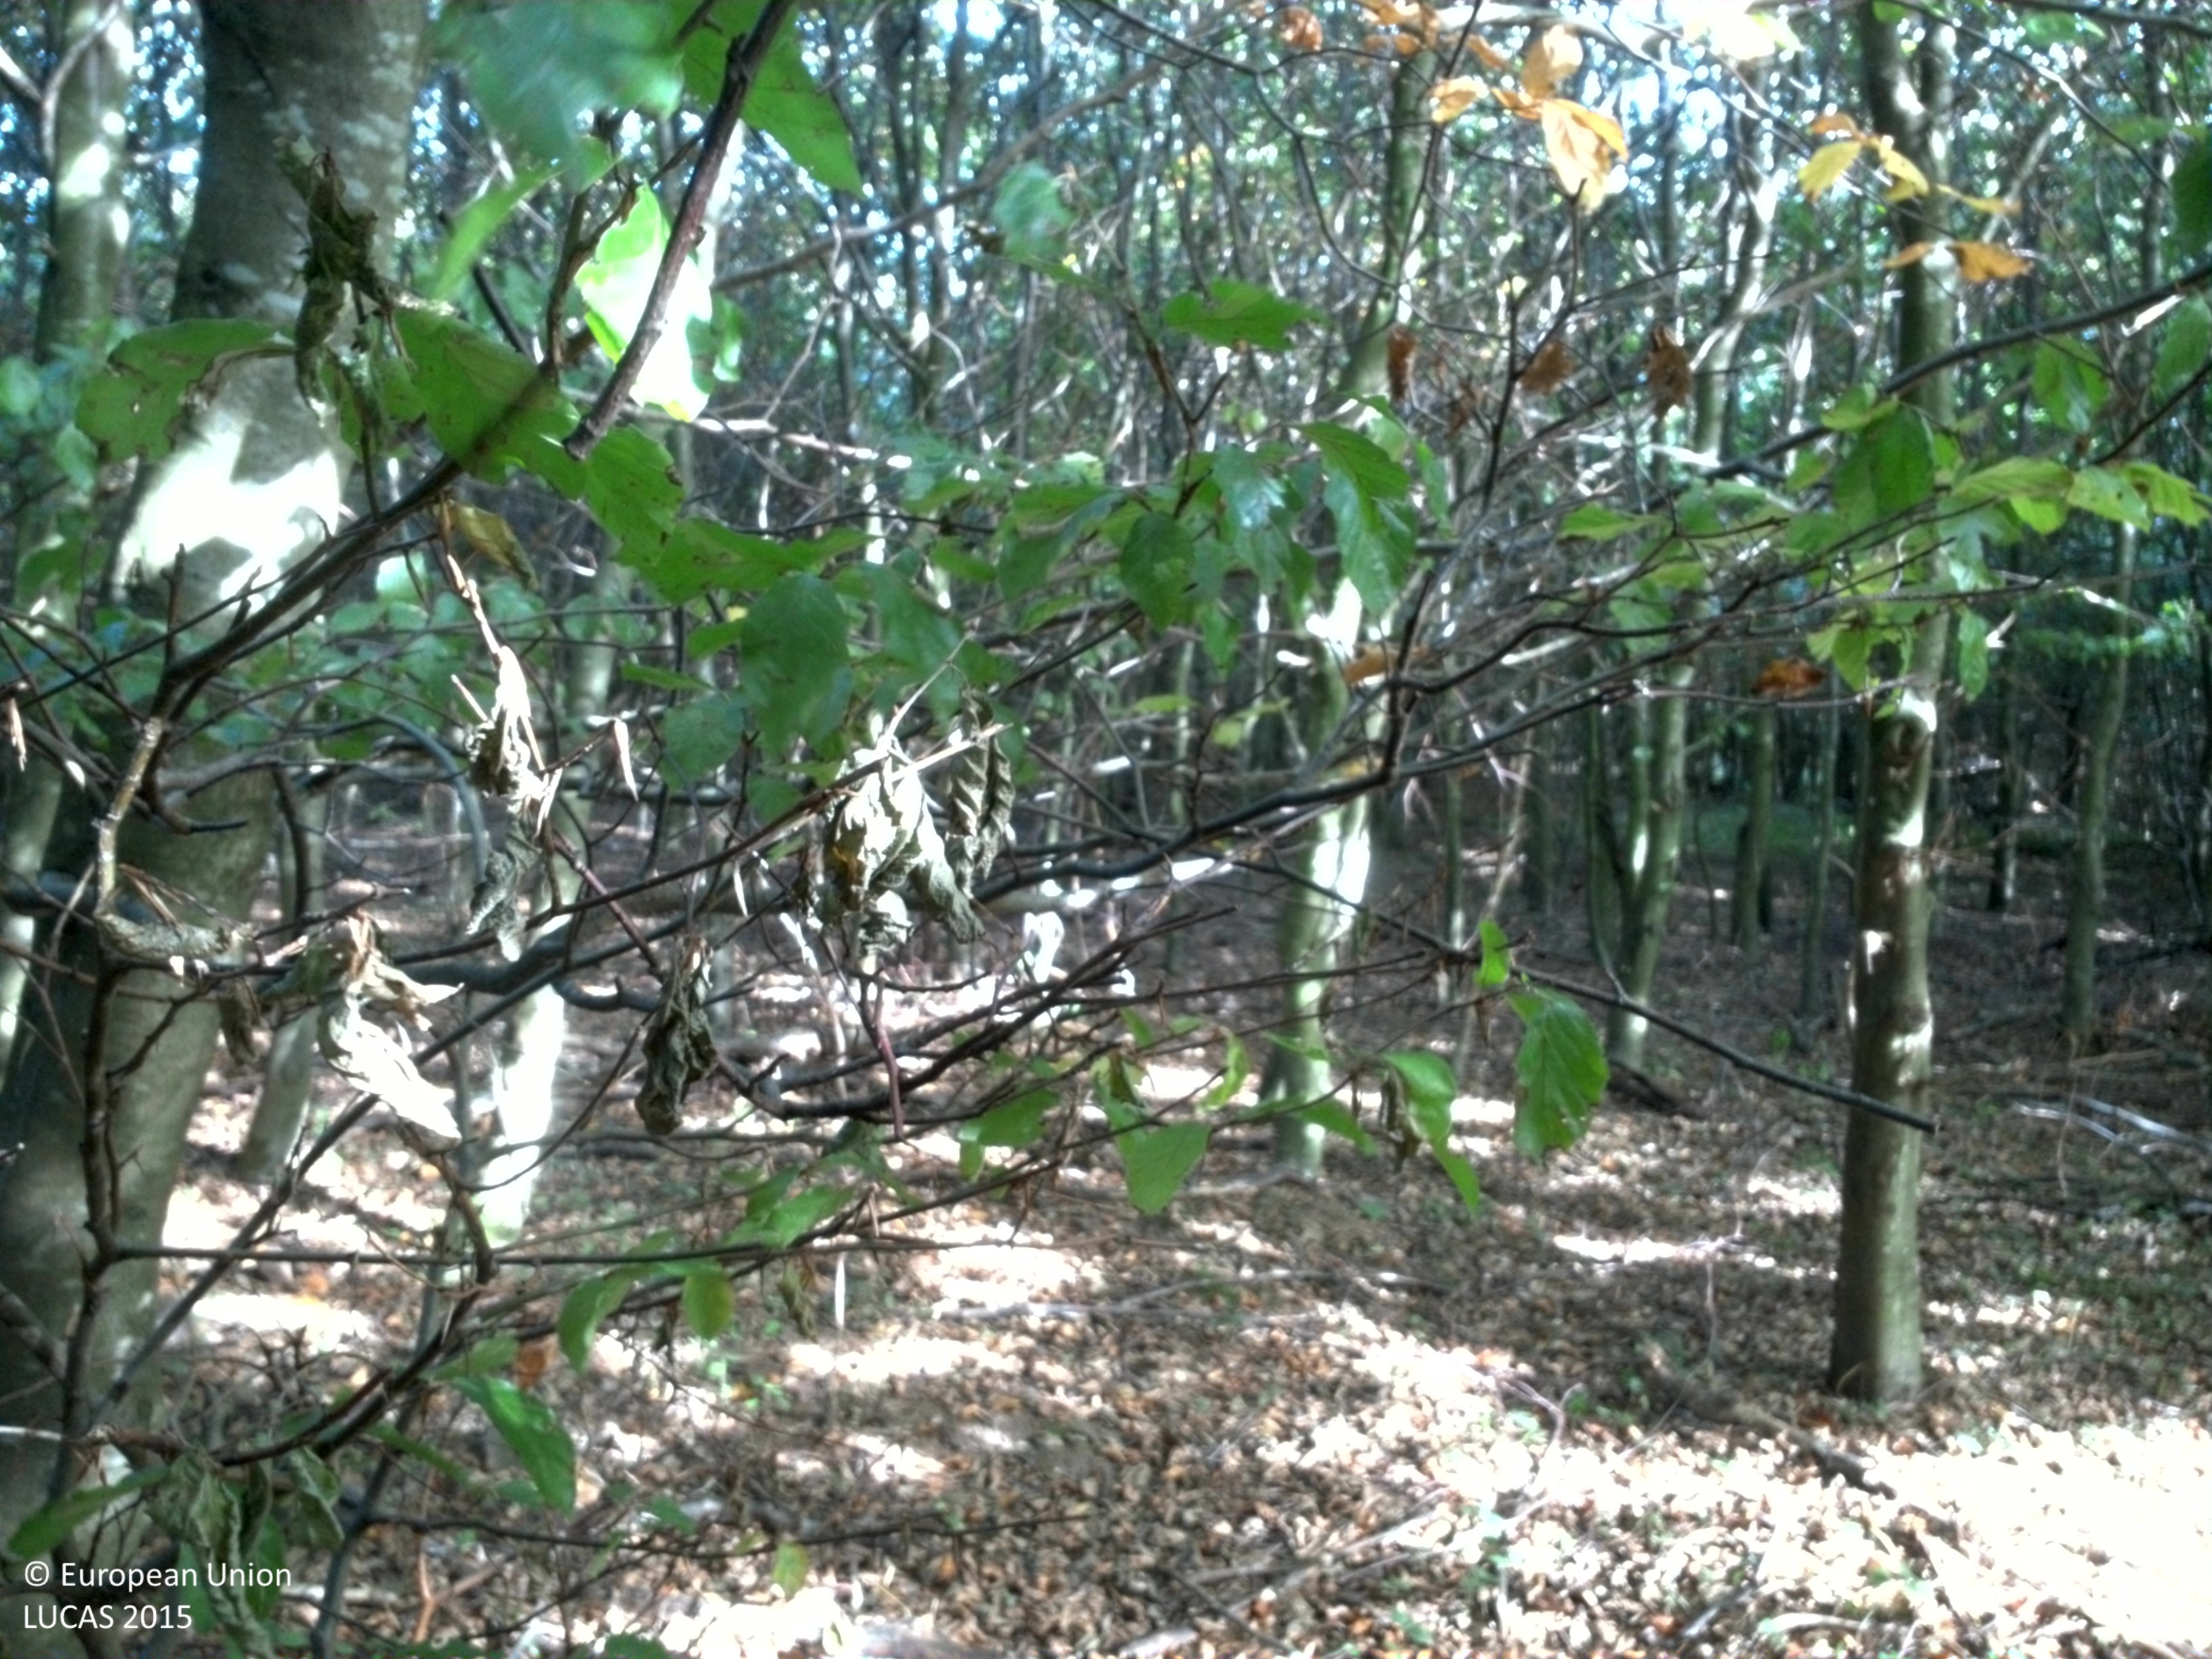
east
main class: Woodland
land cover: Broadleaved woodland
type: beech forest
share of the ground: > 75 %
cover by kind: broadleaved forest trees 90 %, herbaceous plants 5 %, unconsolidated bare surface 5 %
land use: Forestry
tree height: < 5 m
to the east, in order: Broadleaved woodland
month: October
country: SE
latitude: 55.6854
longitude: 13.6723
